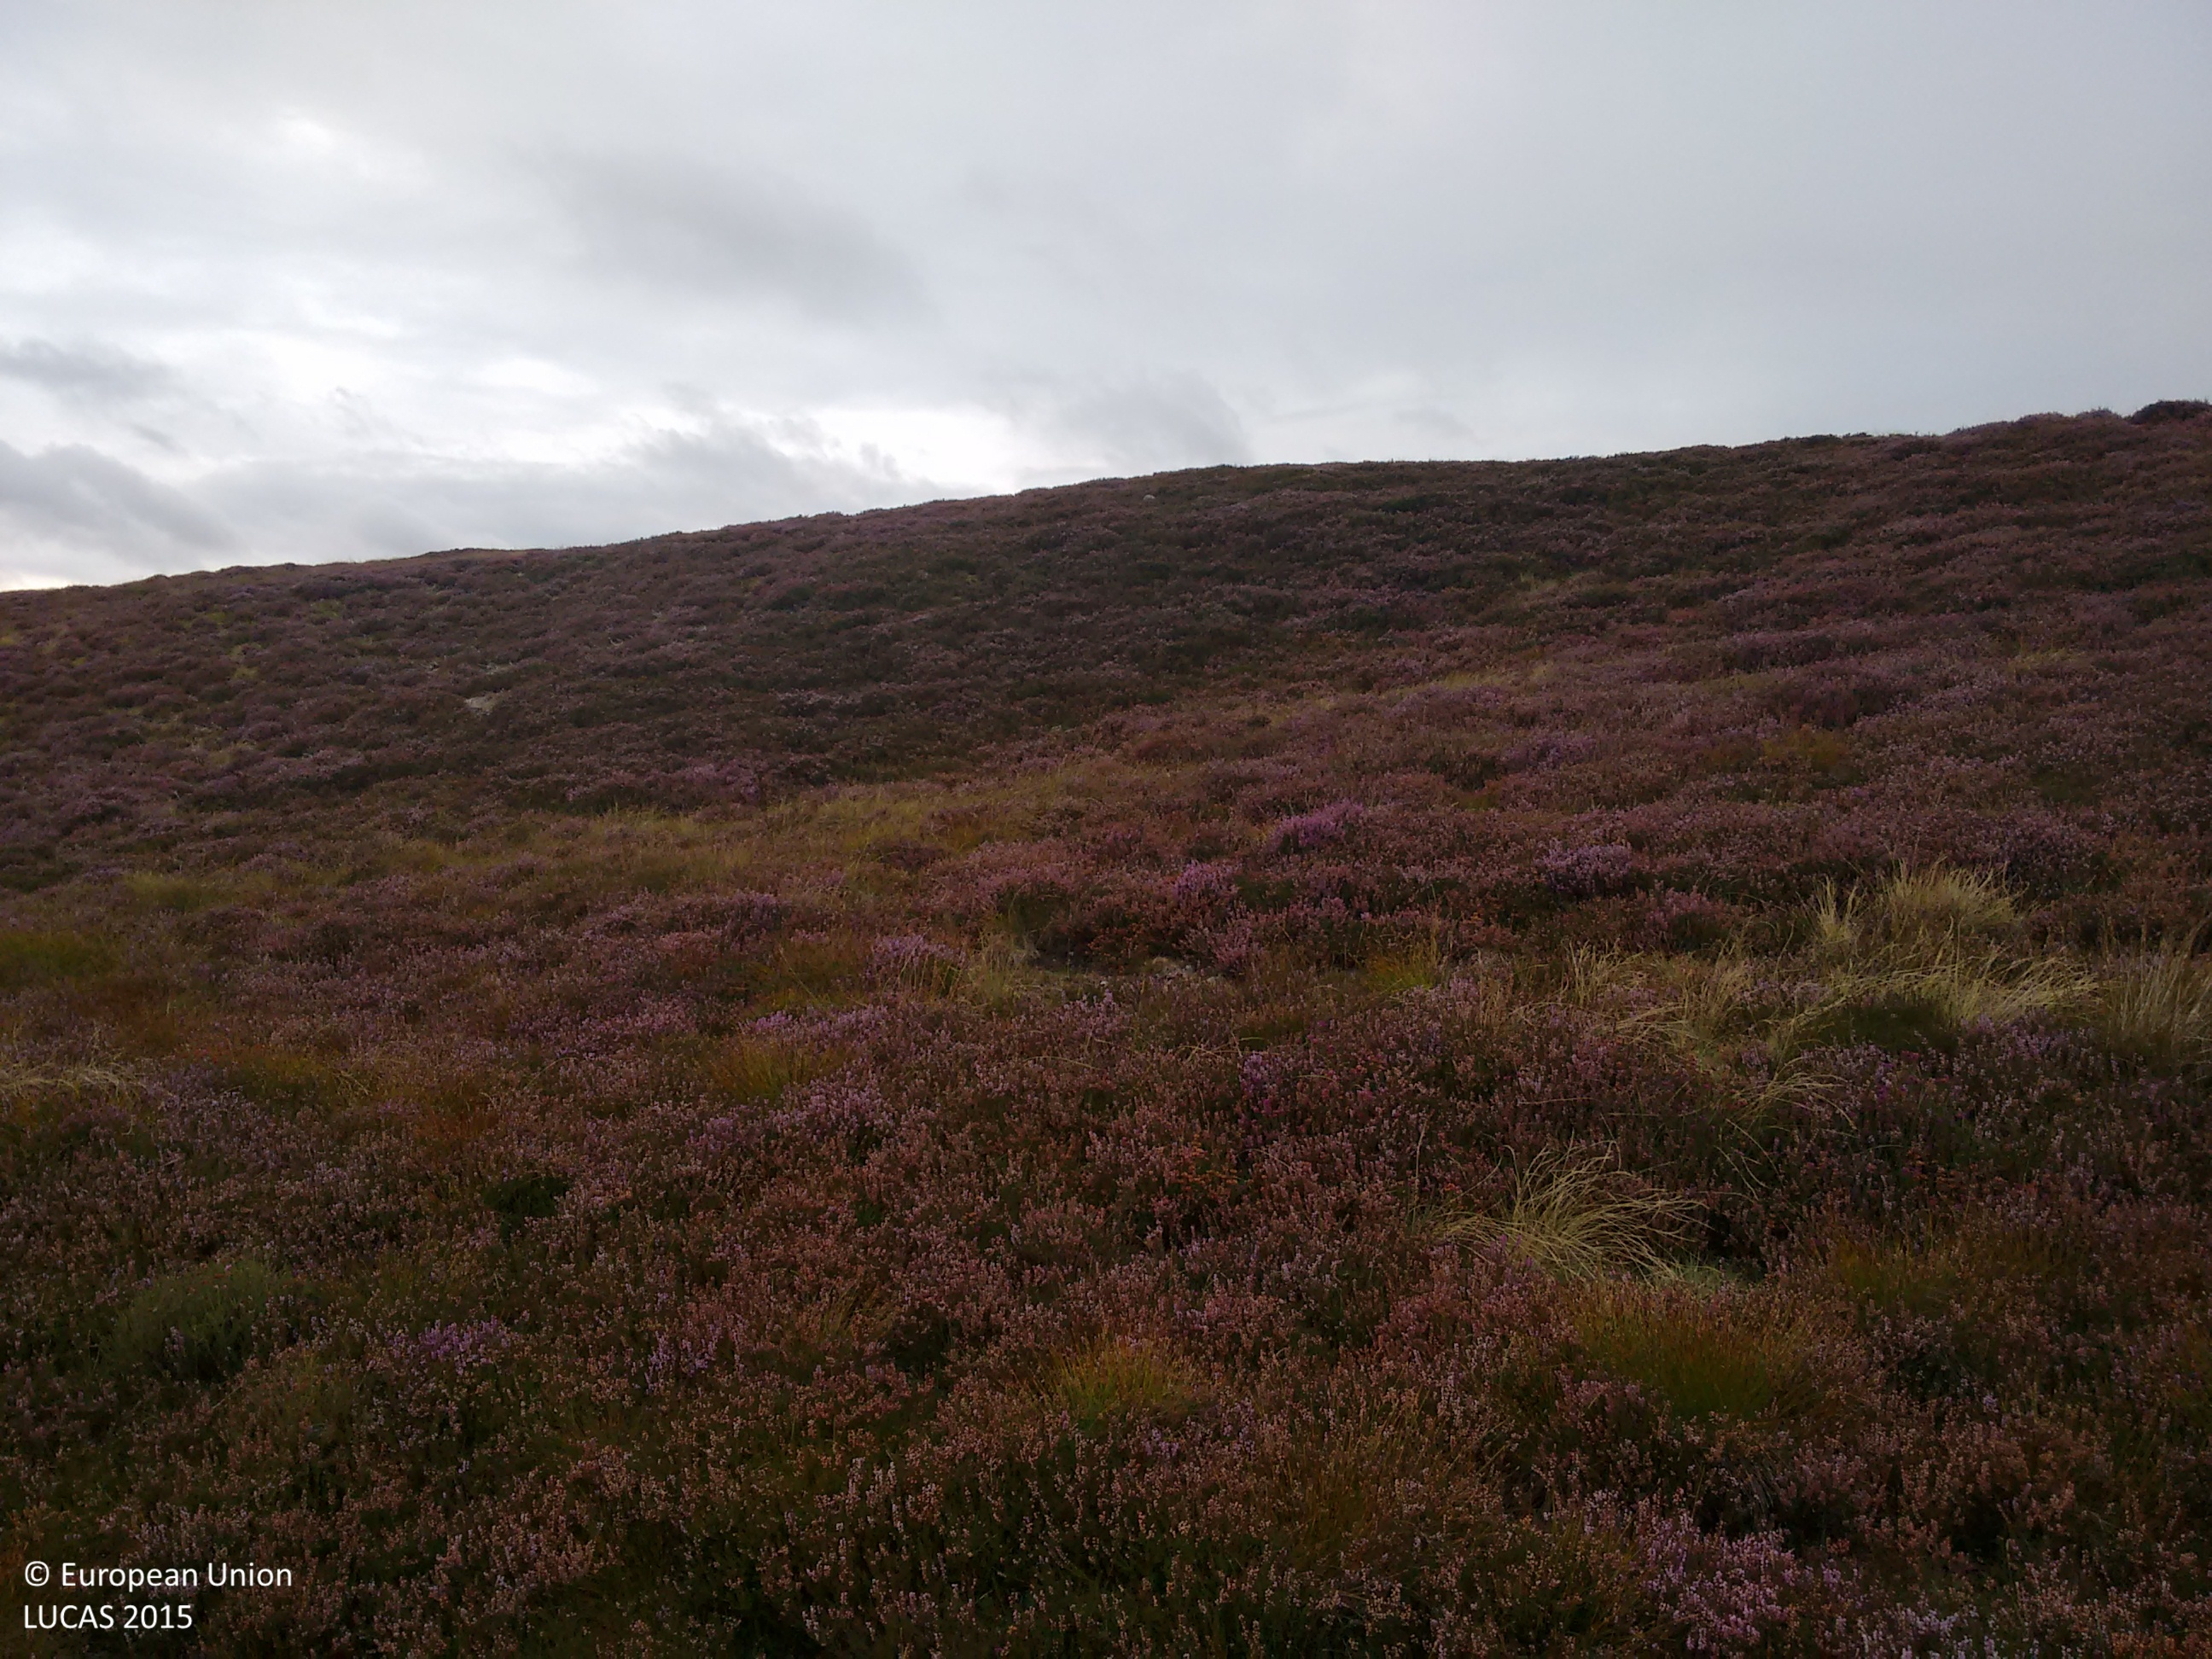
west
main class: Shrubland
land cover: Shrubland without tree cover
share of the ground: > 75 %
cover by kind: shrubs 80 %, herbaceous plants 20 %
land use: Agriculture (excluding fallow land and kitchen gardens)
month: September
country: GB
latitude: 57.4562
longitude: -3.8955
